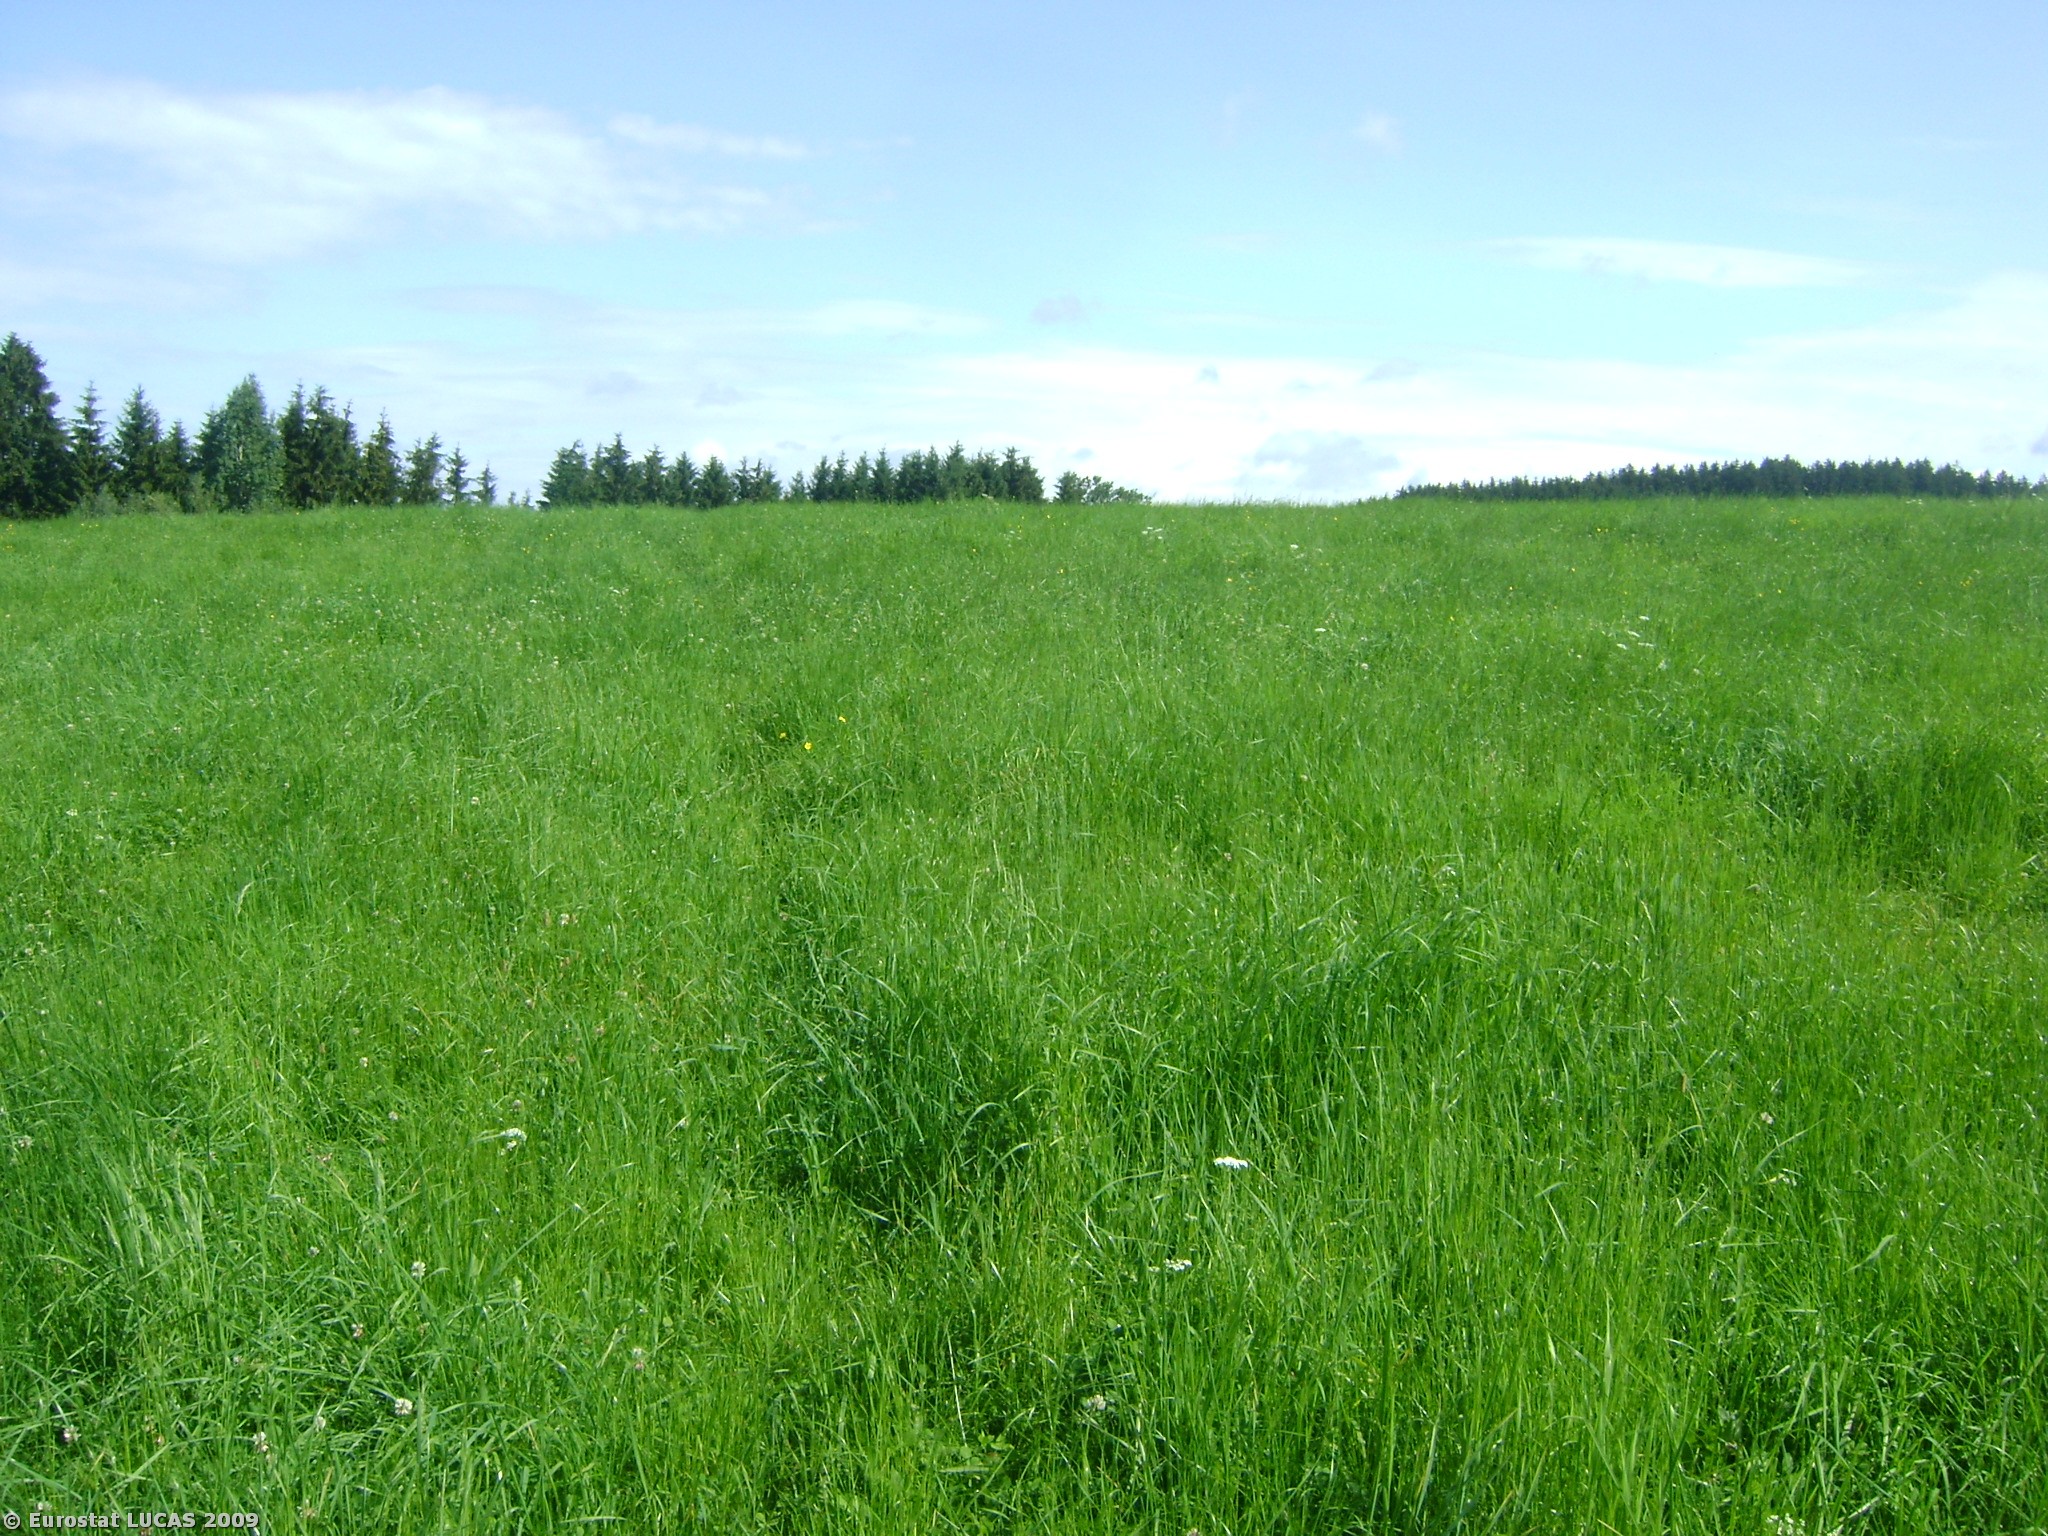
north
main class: Grassland
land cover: Grassland without tree/shrub cover
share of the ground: > 75 %
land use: Agriculture (excluding fallow land and kitchen gardens)
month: July
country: AT
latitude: 48.0411
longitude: 13.5268
